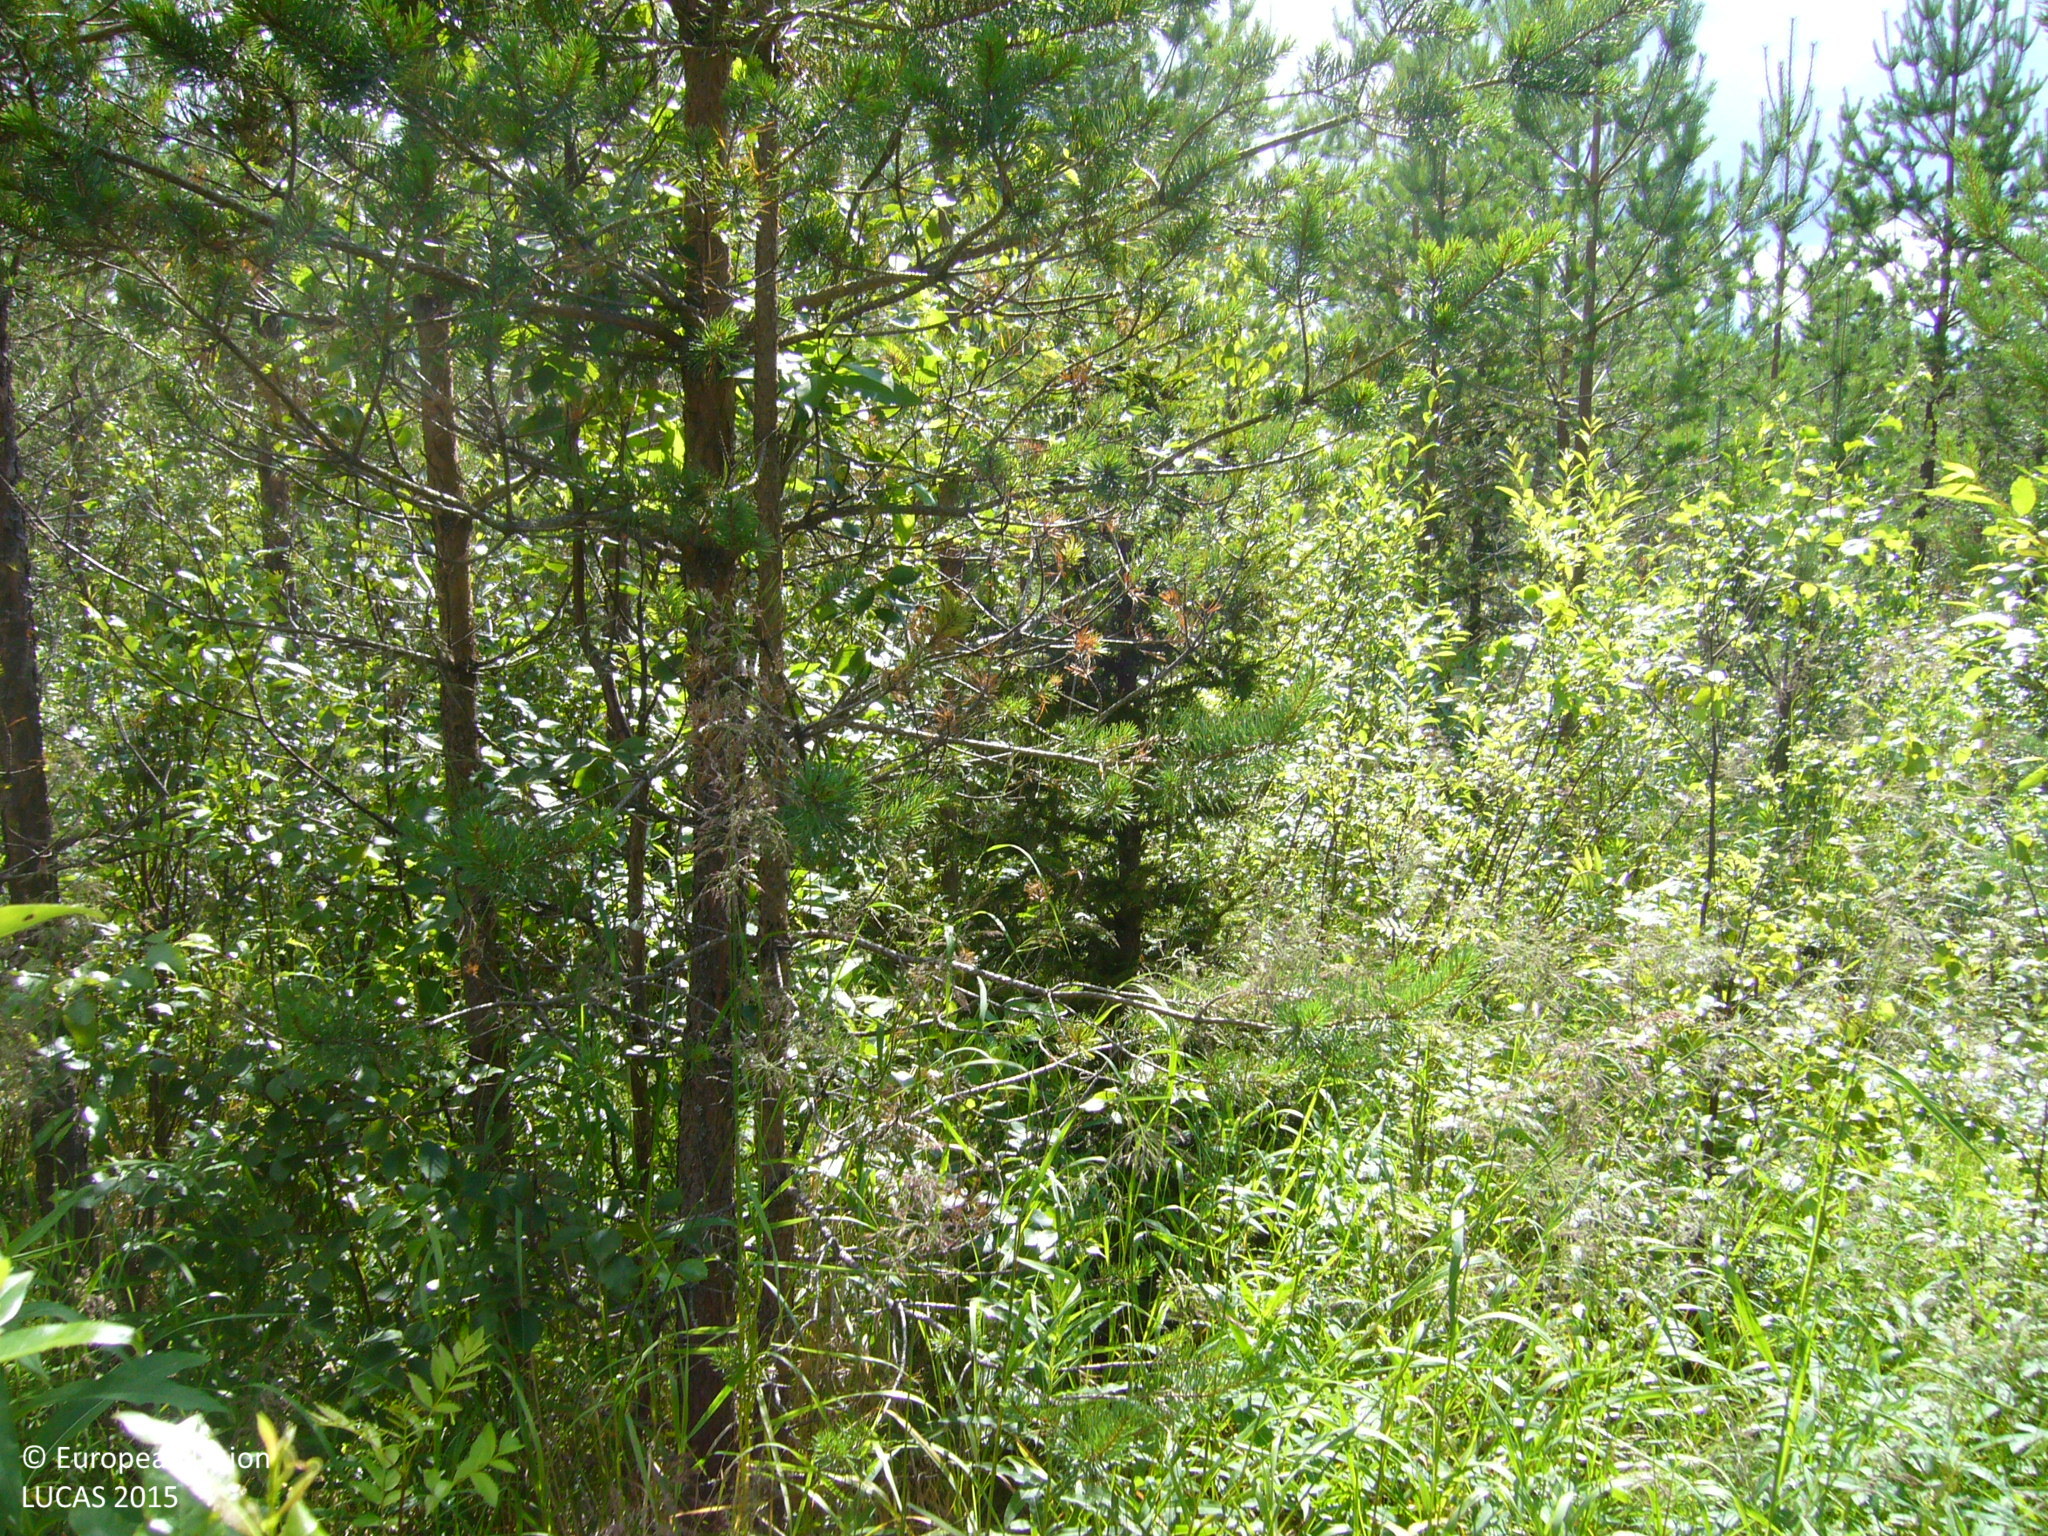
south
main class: Woodland
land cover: Pine dominated mixed woodland
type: boreal forest
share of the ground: 50 - 75 %
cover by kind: coniferous forest trees 40 %, broadleaved forest trees 30 %, herbaceous plants 30 %
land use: Forestry
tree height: > 5 m
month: July
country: FI
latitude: 63.9787
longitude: 26.0658
